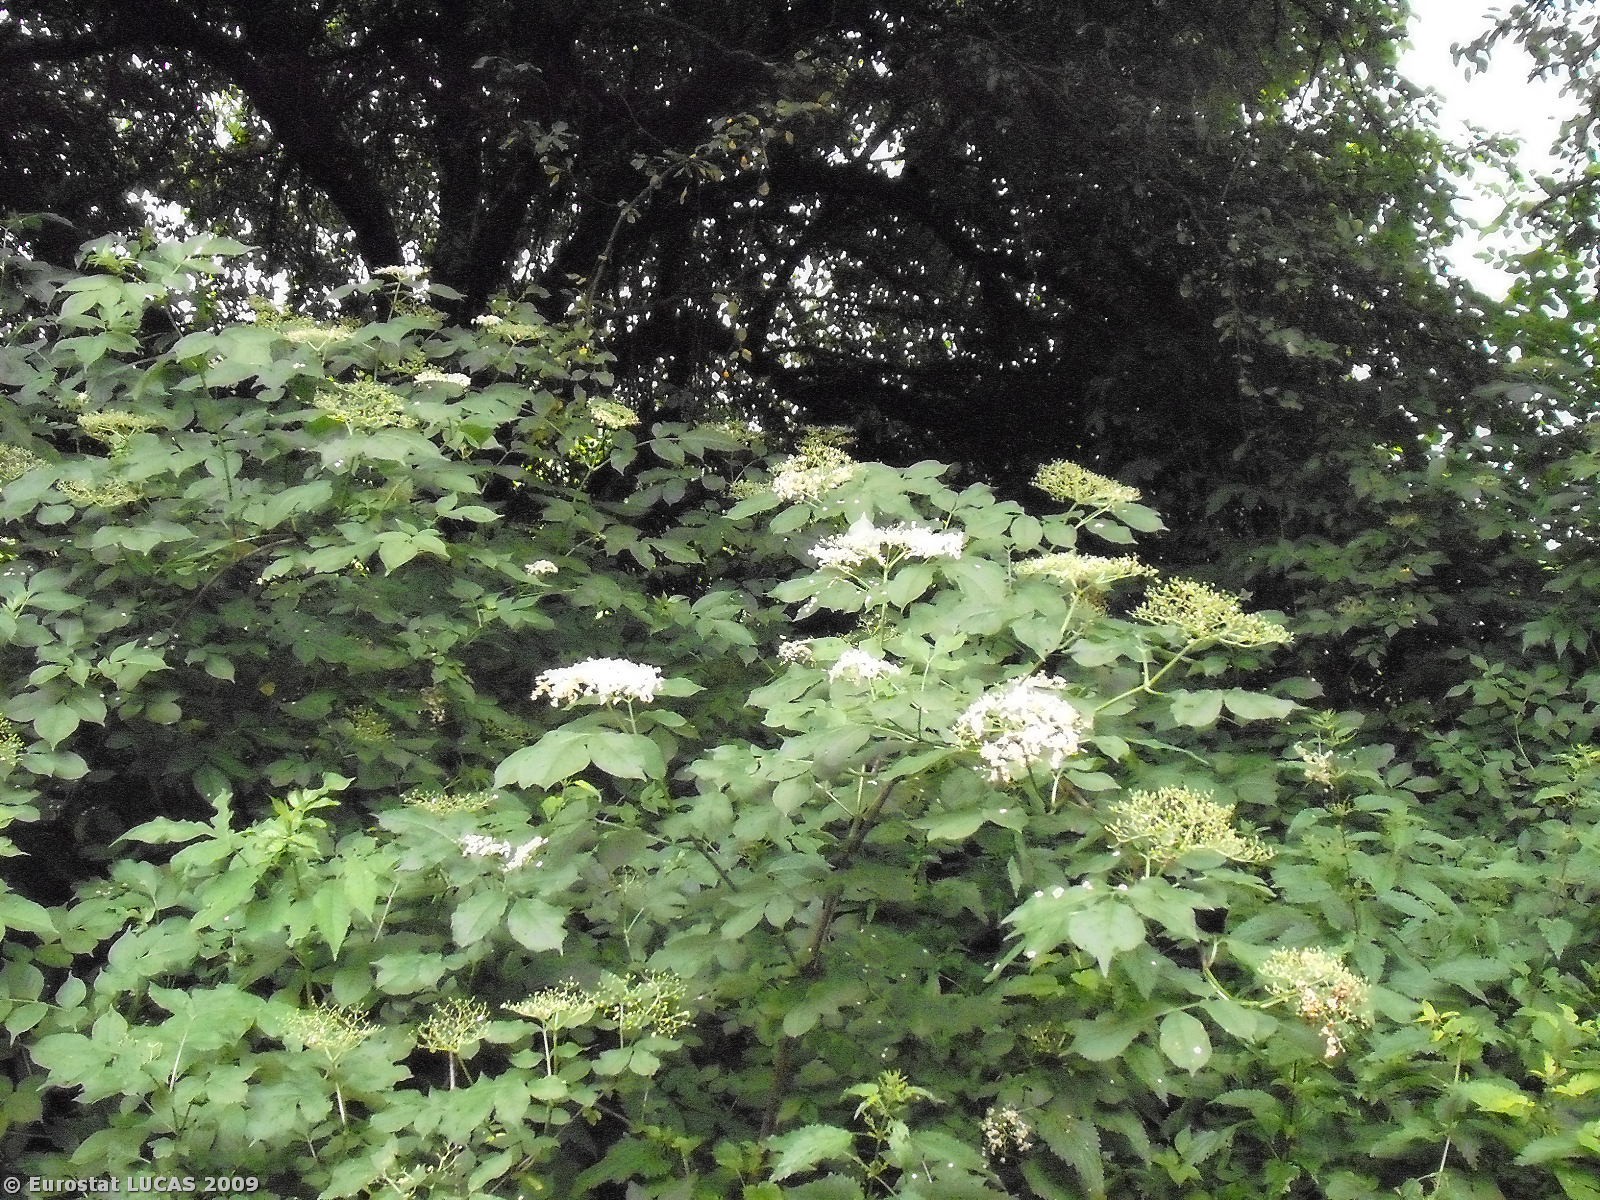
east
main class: Woodland
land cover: Broadleaved woodland
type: mesophytic deciduous forest
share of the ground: > 75 %
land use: Unused
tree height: > 5 m
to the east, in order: Broadleaved woodland; Maize; Grass margins; Sugar beet; Lines of trees; Tracks; Lines of trees; Grassland without tree/shrub cover; Common wheat
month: June
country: PL
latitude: 50.7859
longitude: 21.2676
